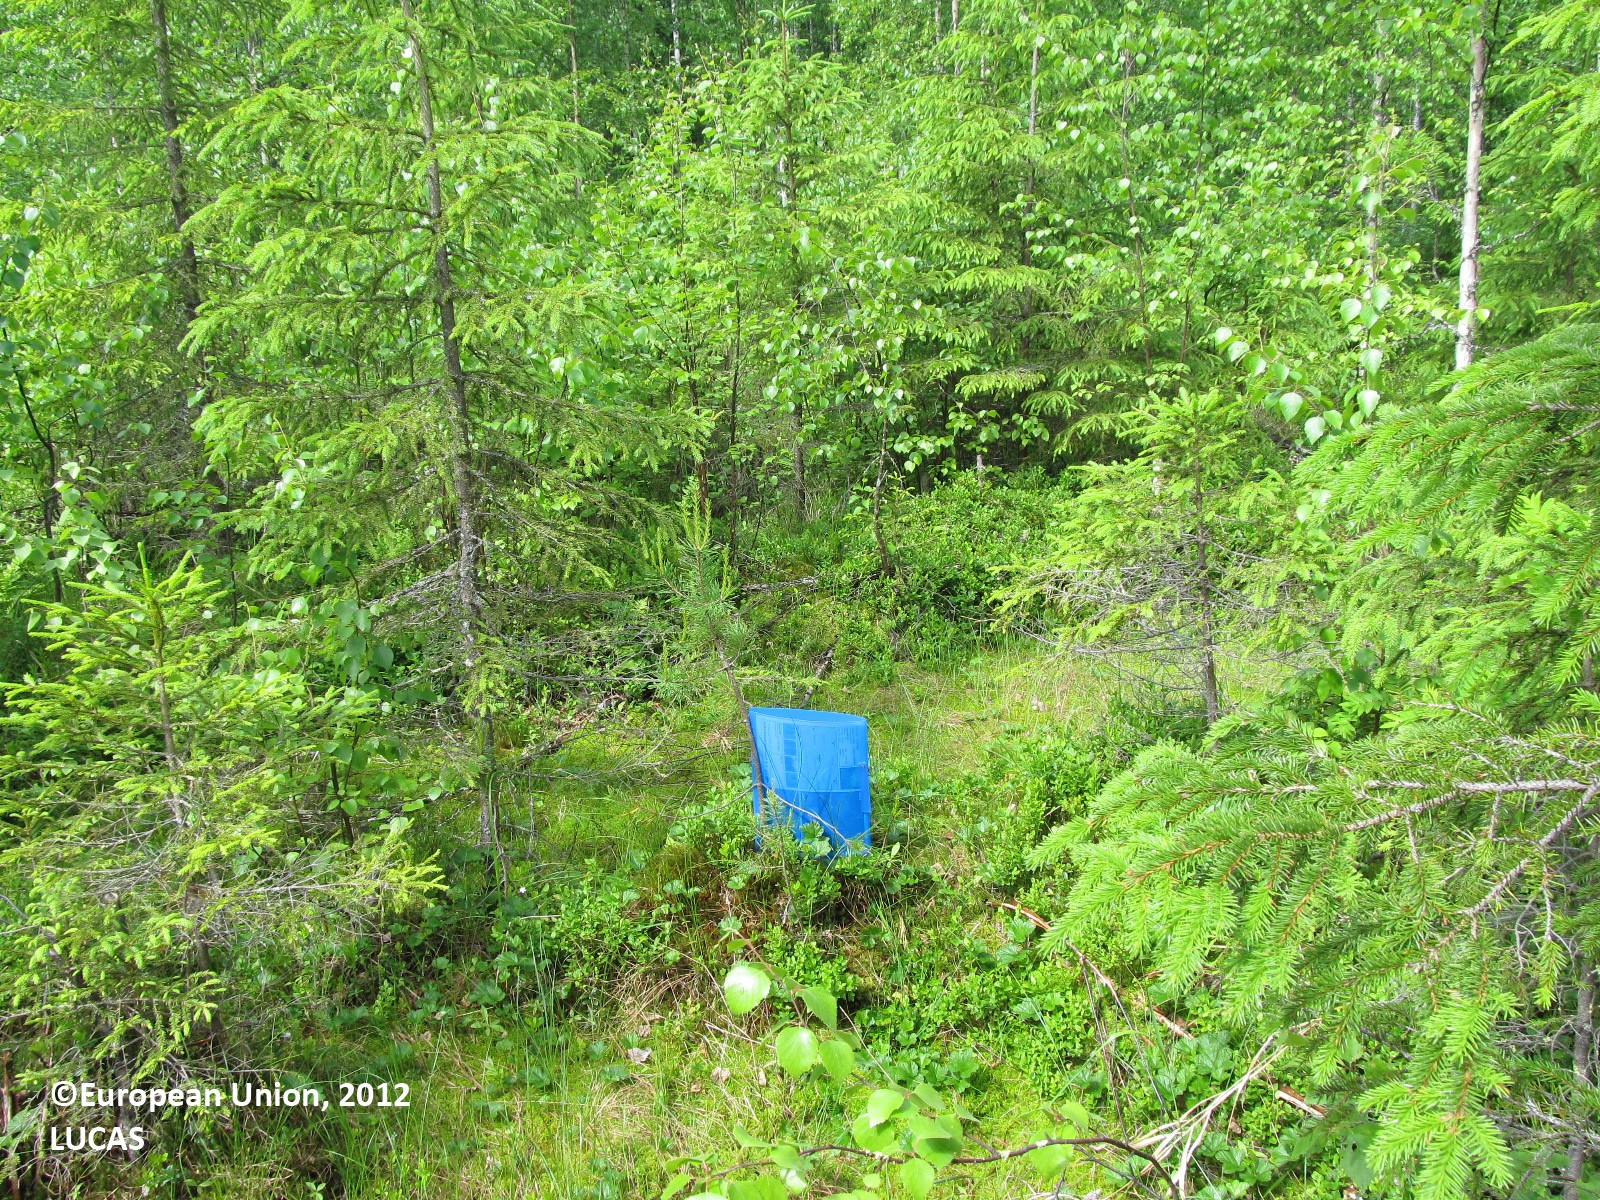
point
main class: Woodland
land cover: Spruce dominated mixed woodland
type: boreal forest
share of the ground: 50 - 75 %
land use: Forestry
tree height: < 5 m
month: June
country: FI
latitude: 62.9956
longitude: 28.9458
